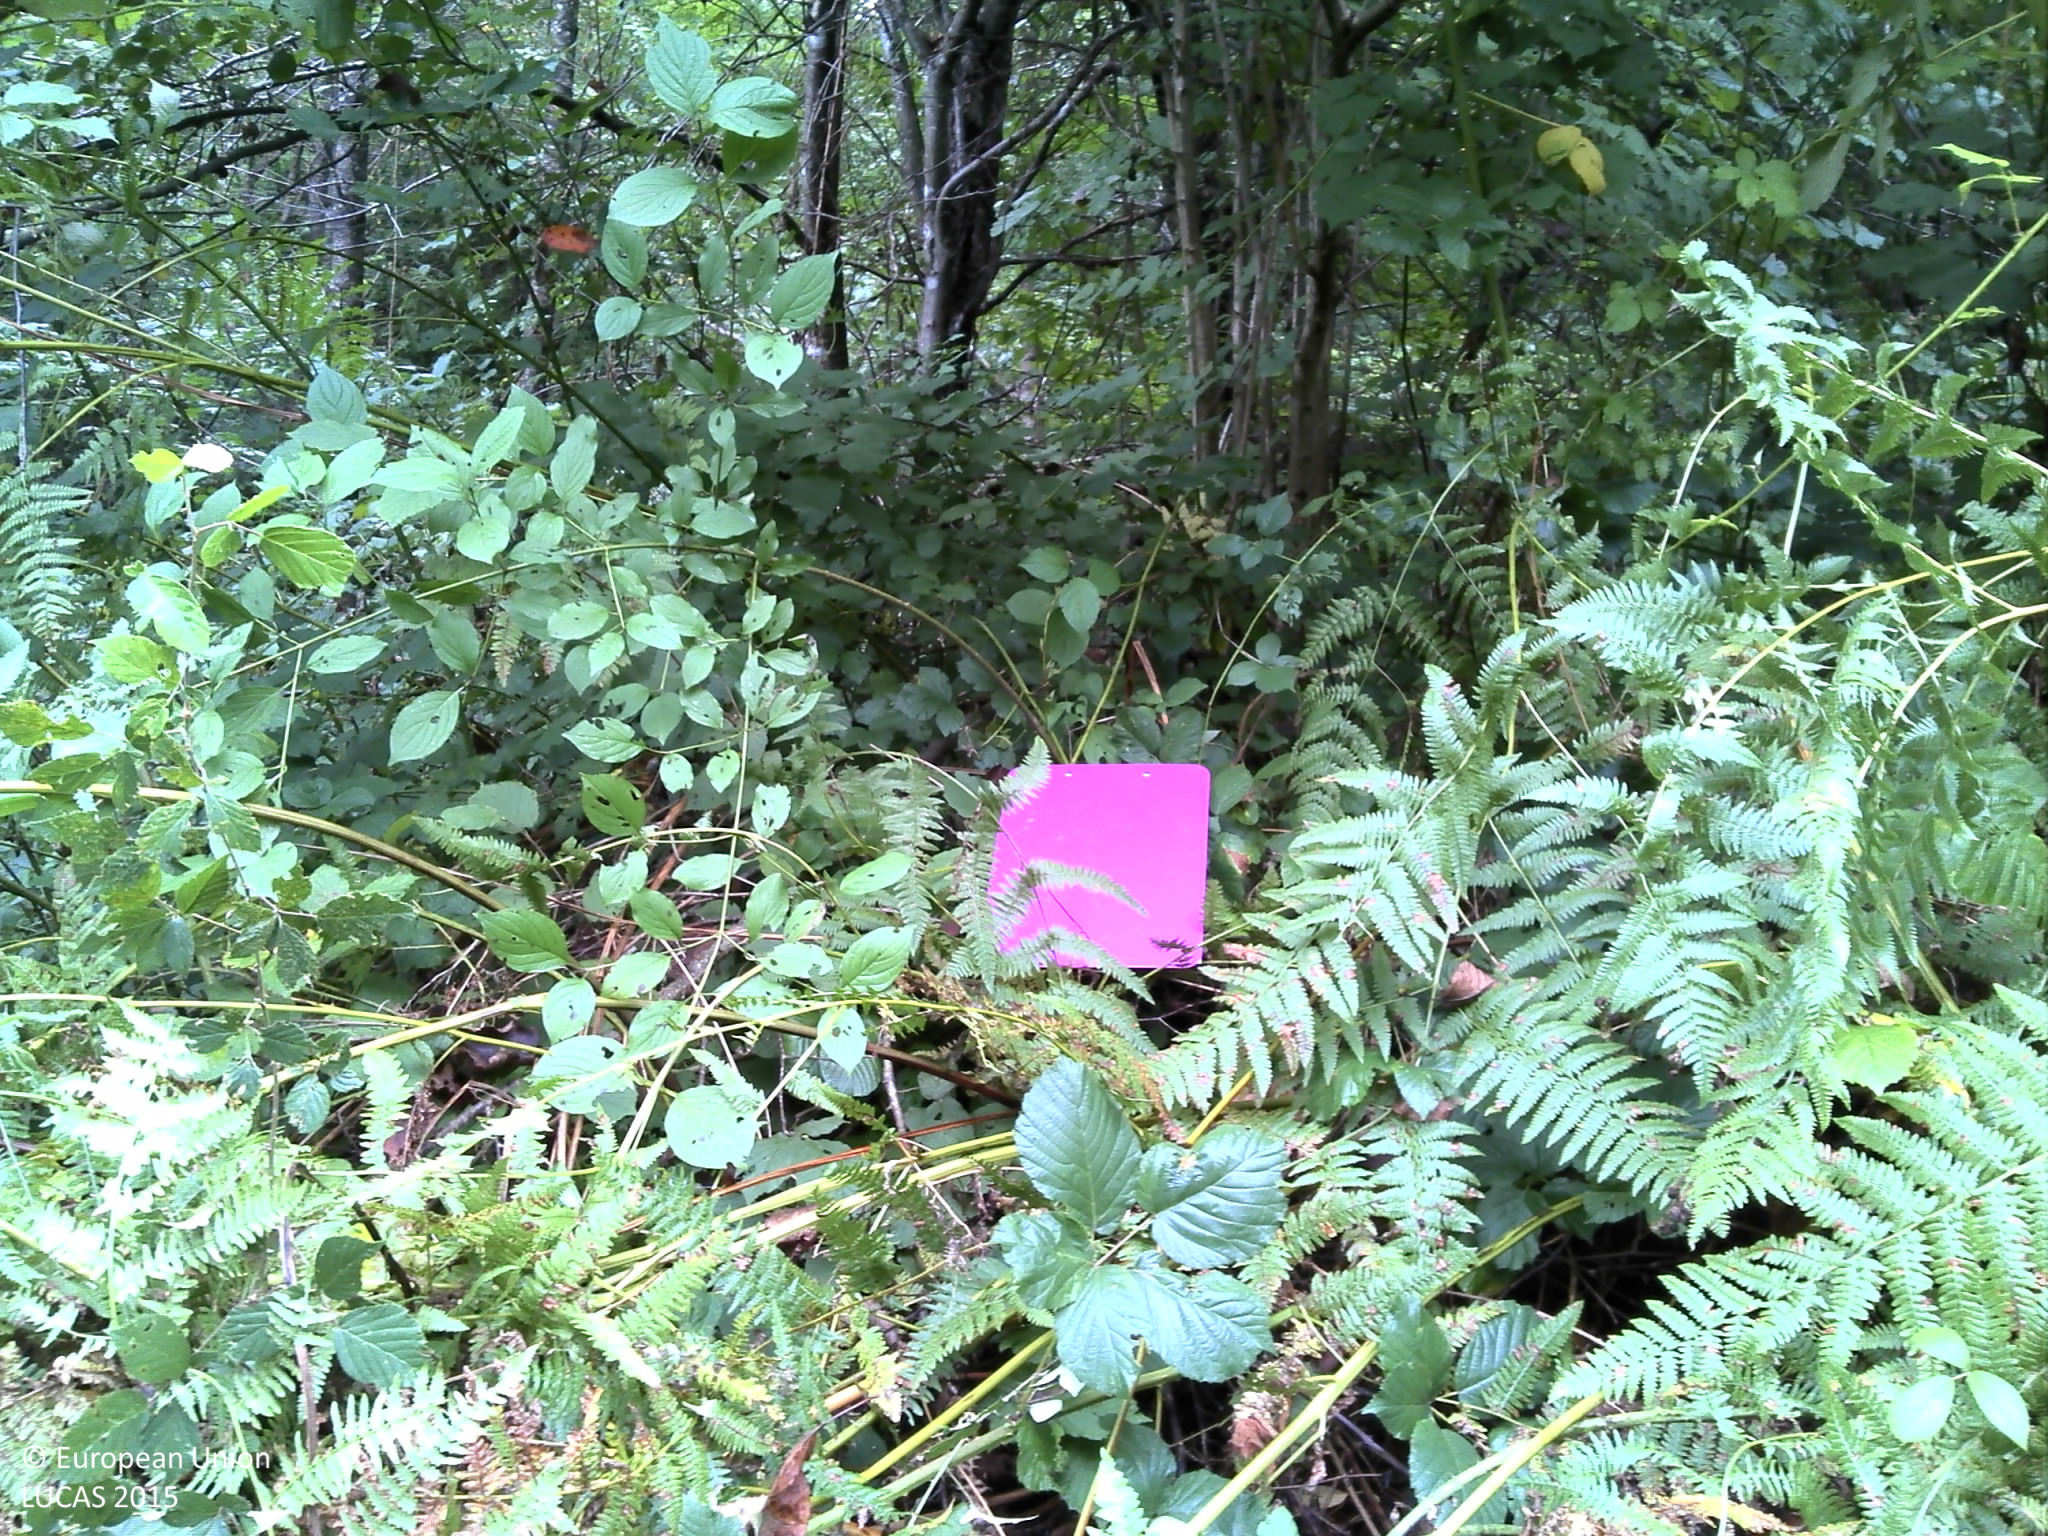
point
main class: Woodland
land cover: Broadleaved woodland
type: mesophytic deciduous forest
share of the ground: 50 - 75 %
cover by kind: broadleaved forest trees 75 %, shrubs 20 %, herbaceous plants 5 %
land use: Semi-natural and natural areas not in use
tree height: > 5 m
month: August
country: HR
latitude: 45.3337
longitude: 15.6743
